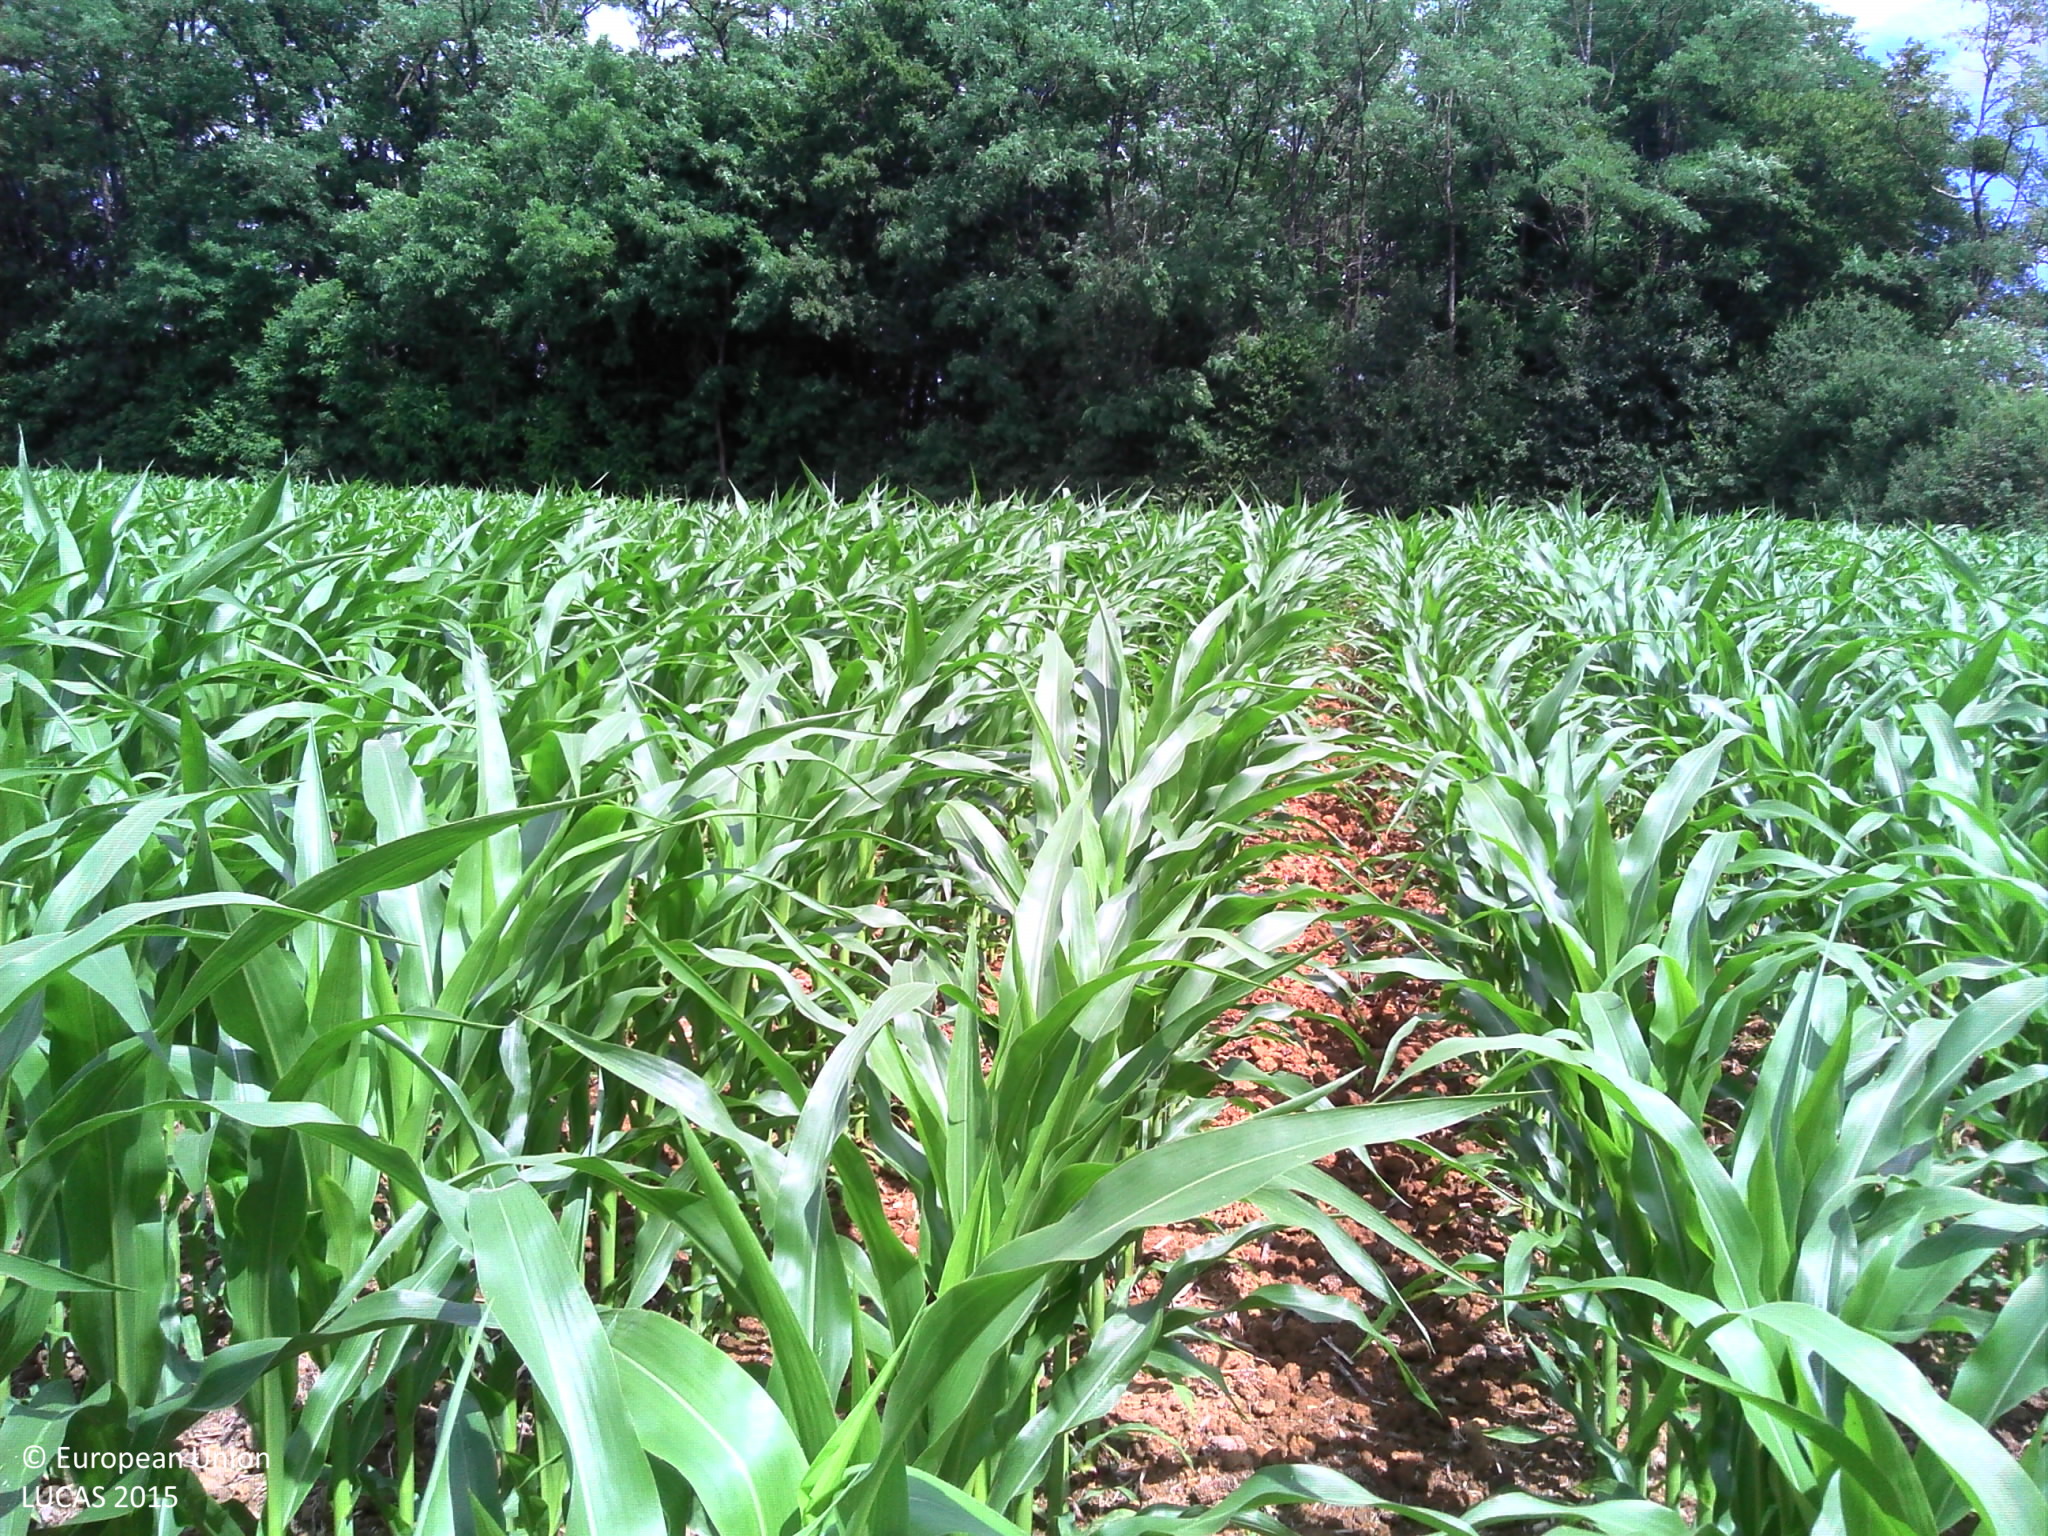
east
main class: Cropland
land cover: Maize
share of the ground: 50 - 75 %
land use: Agriculture (excluding fallow land and kitchen gardens)
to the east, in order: Maize; Broadleaved woodland; Grass margins; Ditches and canals; Grass margins; Paved roads, cycling and walking lanes; Grass margins; Ditches and canals; Grass margins; Soya
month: June
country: FR
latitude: 46.8328
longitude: 5.4789
